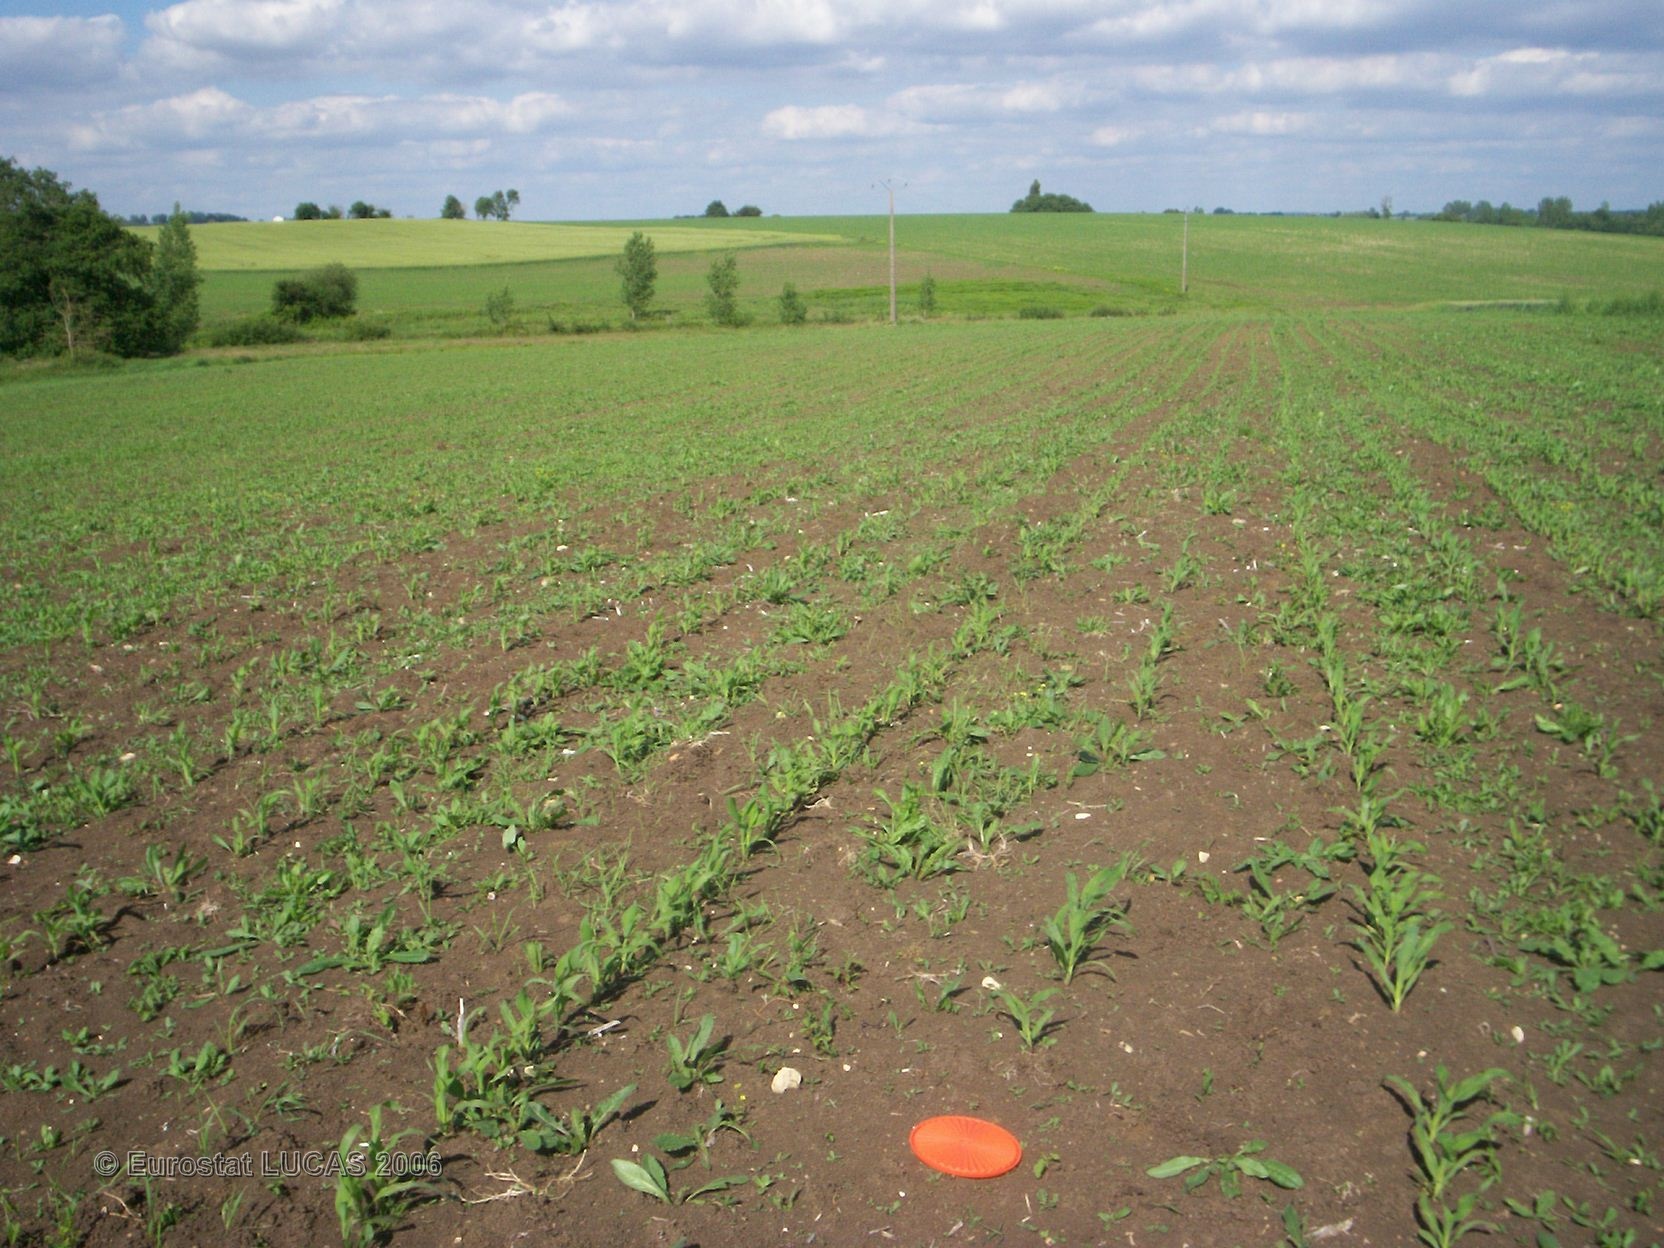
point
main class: Cropland
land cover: Maize
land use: Agriculture (excluding fallow land and kitchen gardens)
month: May
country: FR
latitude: 45.9456
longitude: -0.8243
